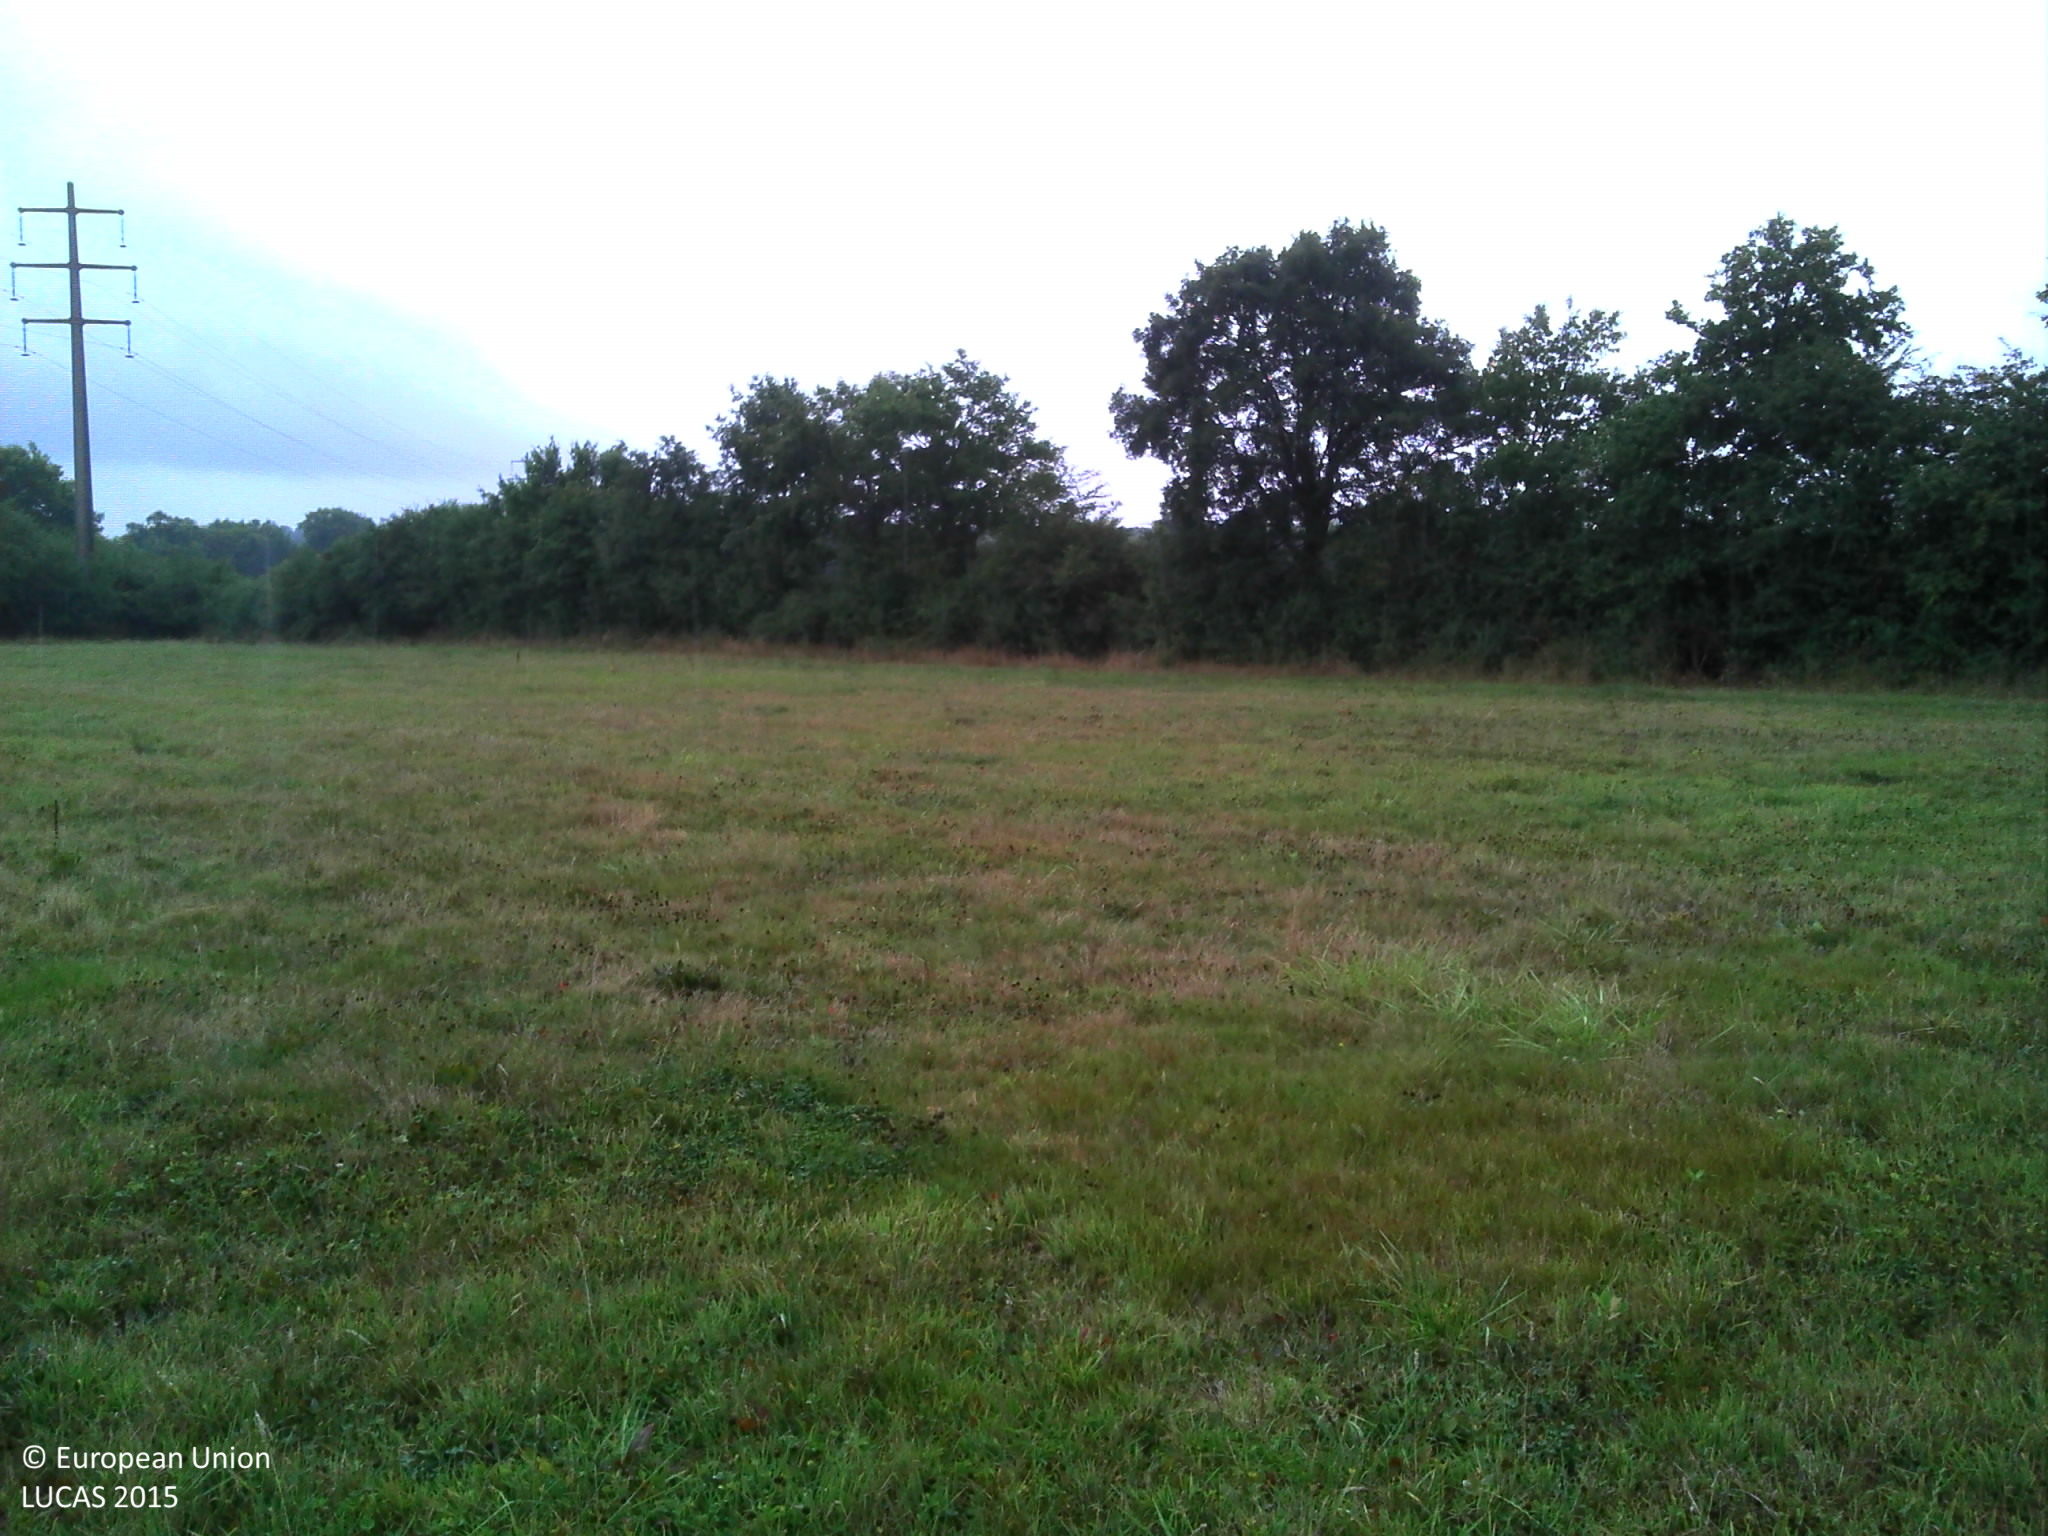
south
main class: Cropland
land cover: Temporary grasslands
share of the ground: > 75 %
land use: Agriculture (excluding fallow land and kitchen gardens)
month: August
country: FR
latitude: 47.5280
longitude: -1.5056
